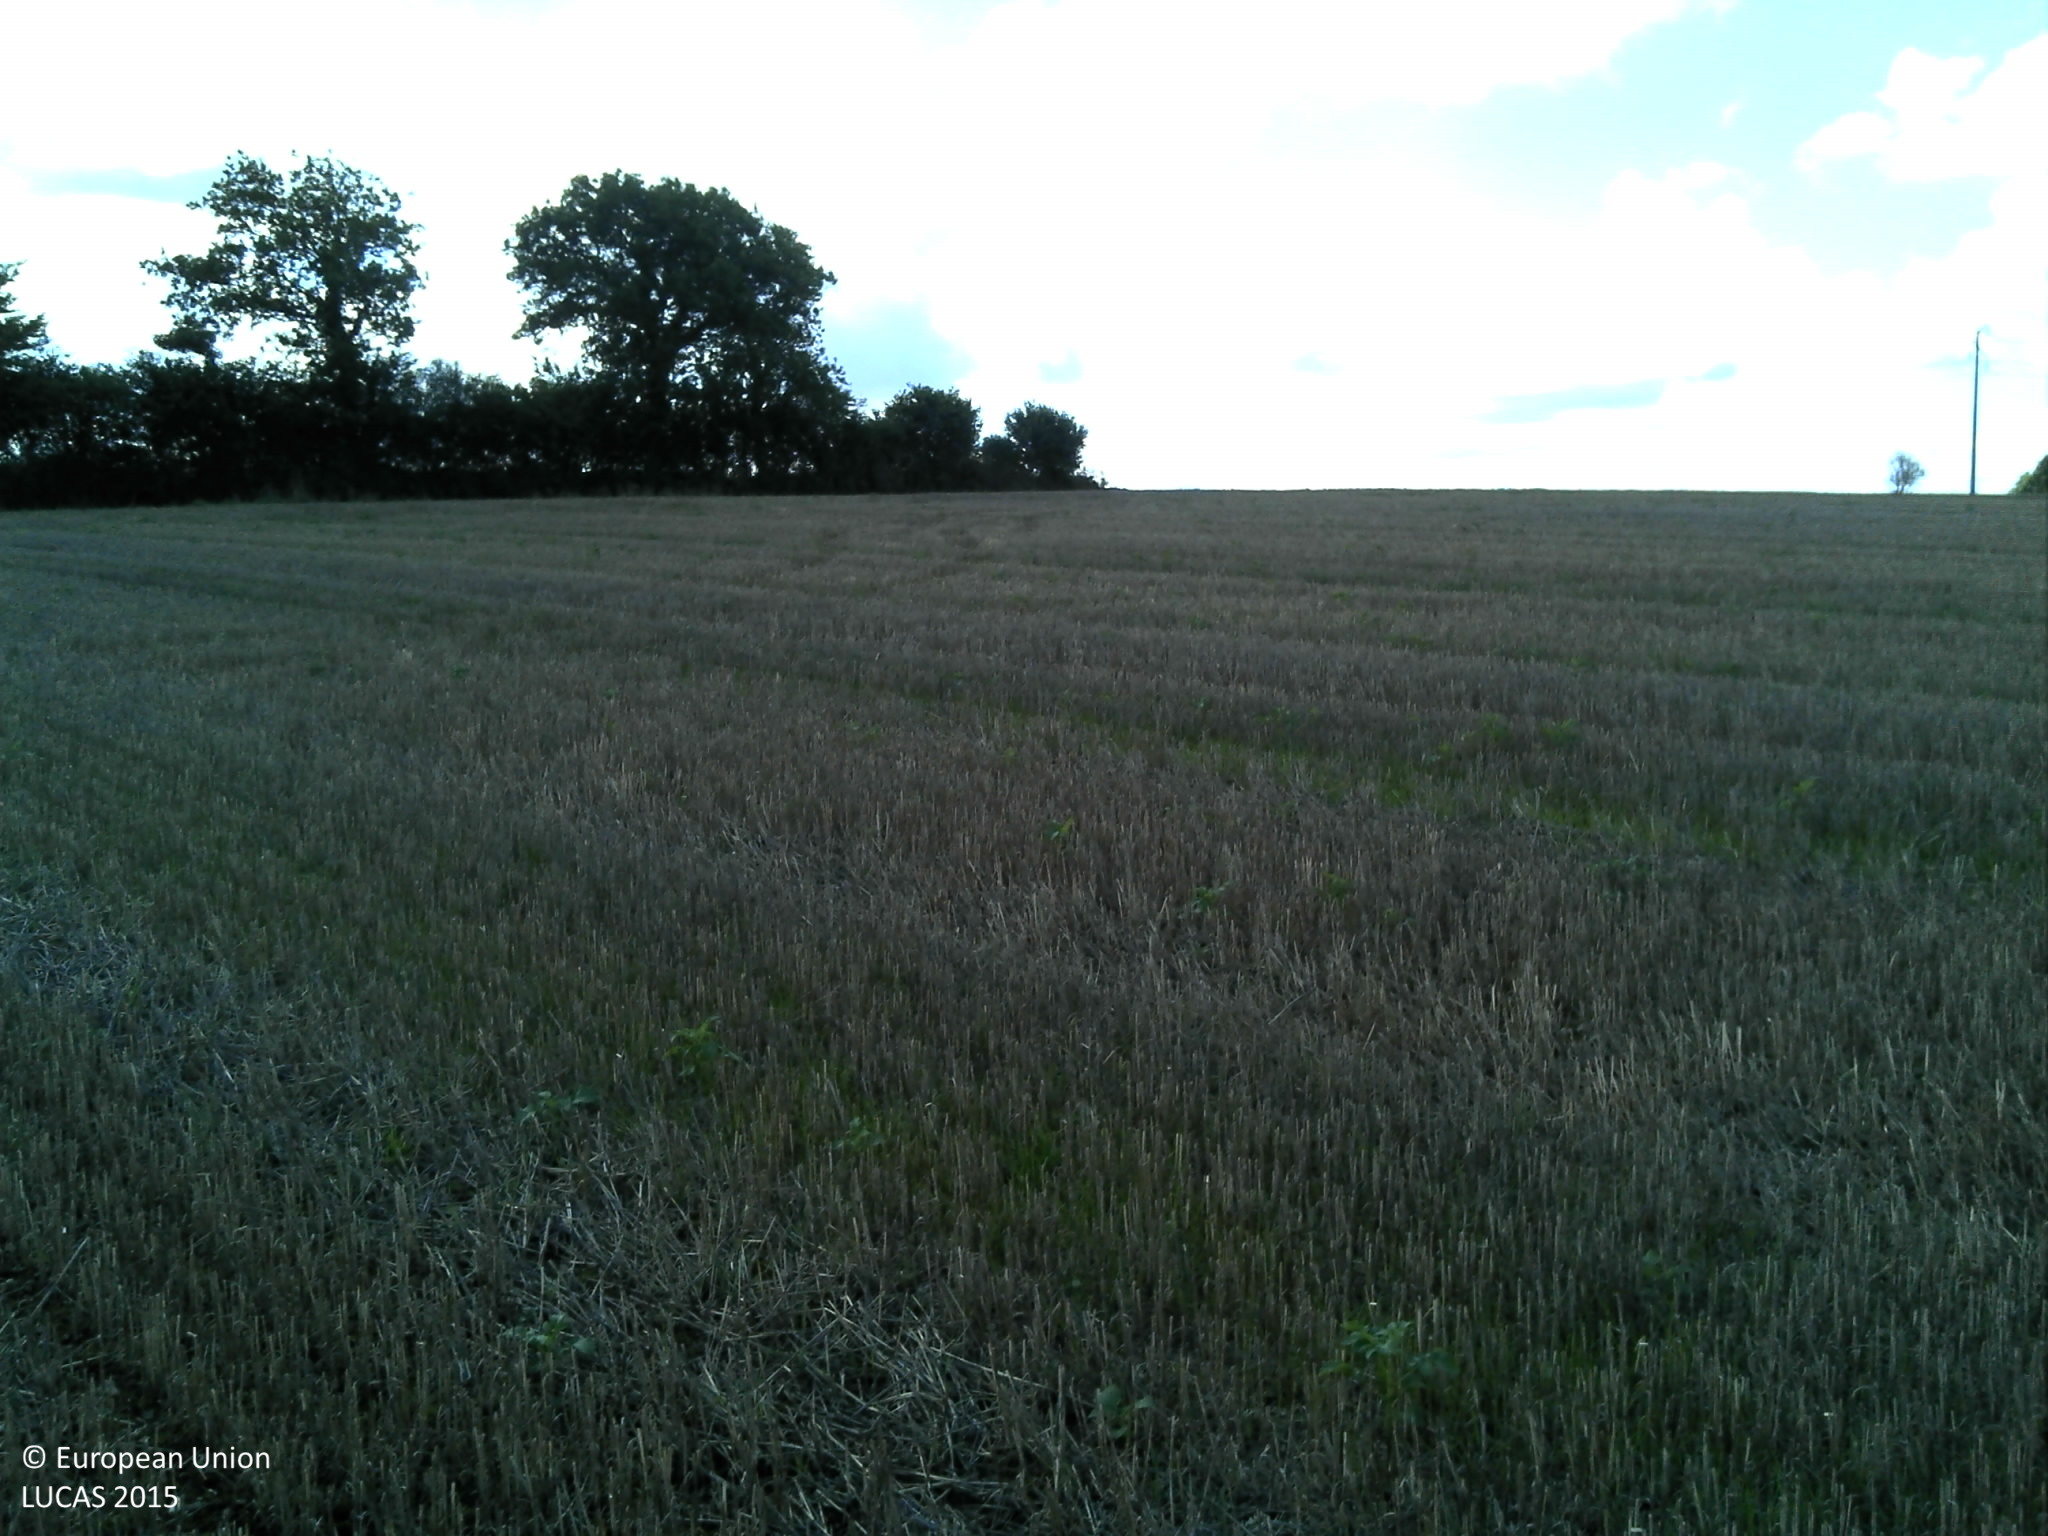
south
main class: Cropland
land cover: Durum wheat
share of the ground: > 75 %
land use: Agriculture (excluding fallow land and kitchen gardens)
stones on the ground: < 10 %
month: September
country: FR
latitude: 48.3620
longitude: -4.1690
